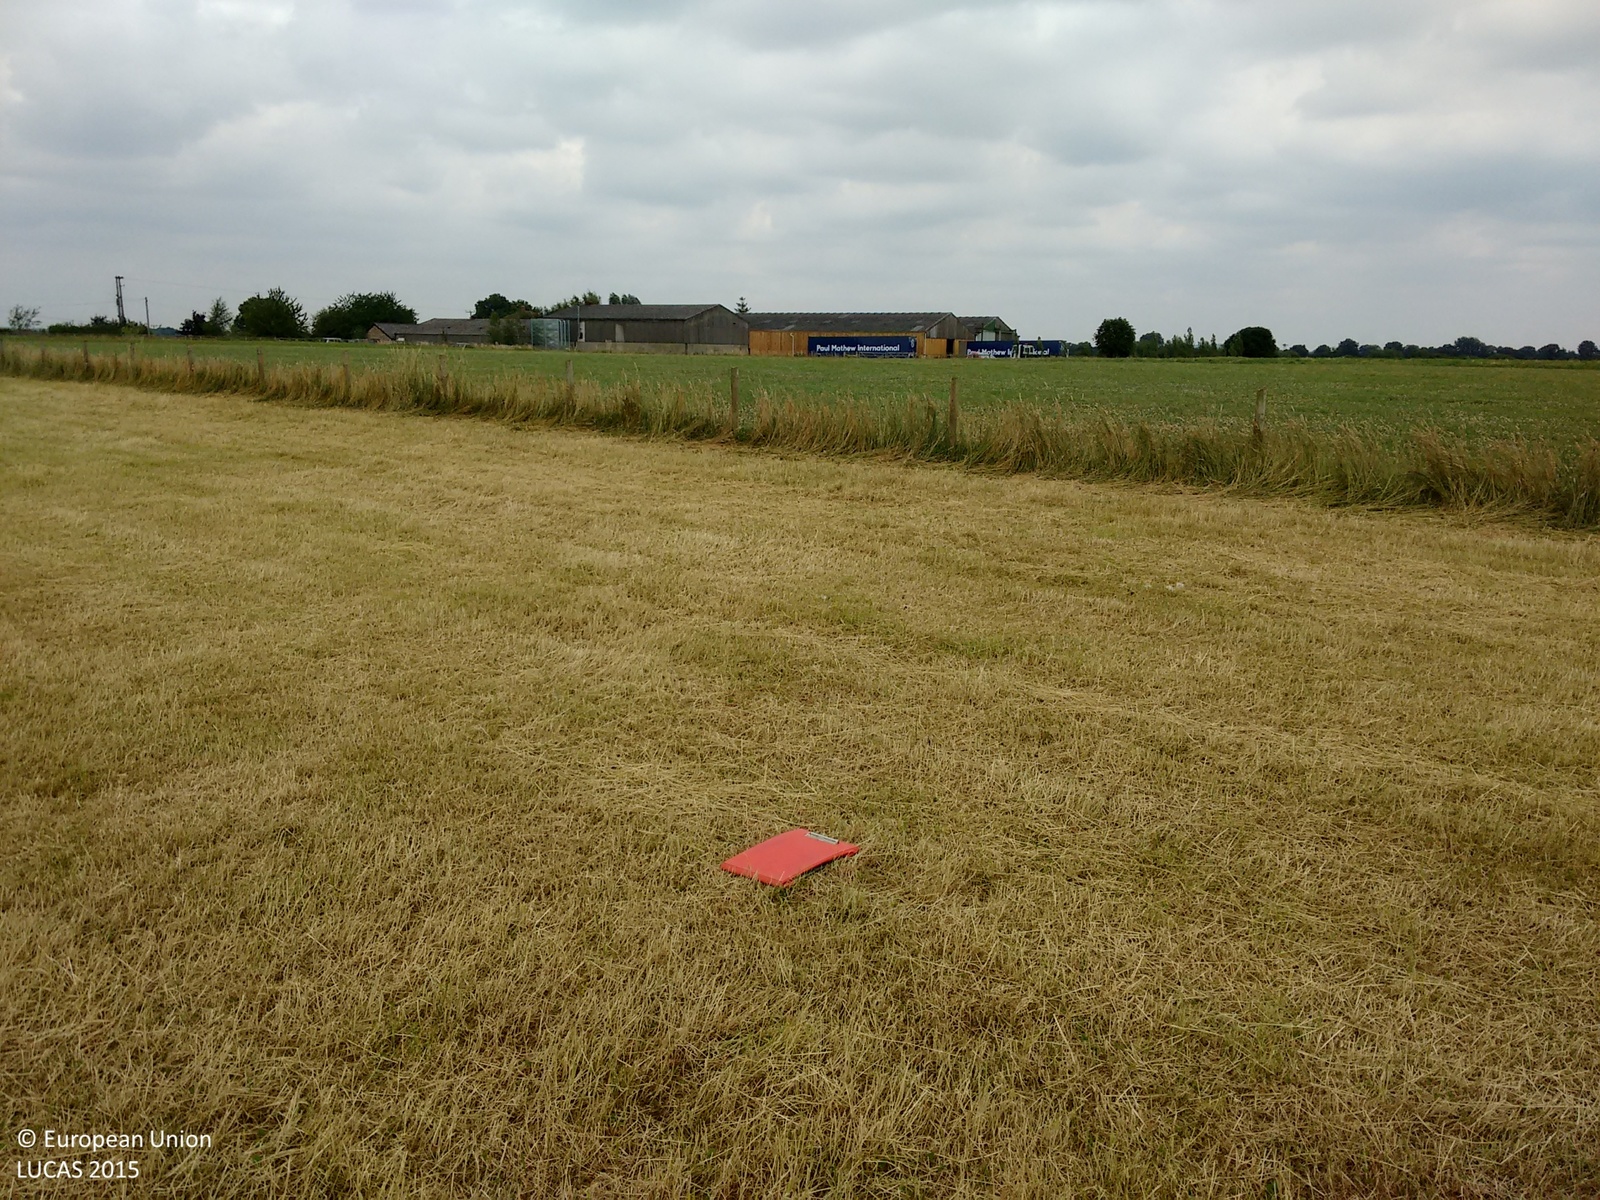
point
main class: Grassland
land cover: Grassland without tree/shrub cover
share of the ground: > 75 %
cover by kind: herbaceous plants 100 %
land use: Agriculture (excluding fallow land and kitchen gardens)
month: July
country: GB
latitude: 51.8092
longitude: -1.2007
